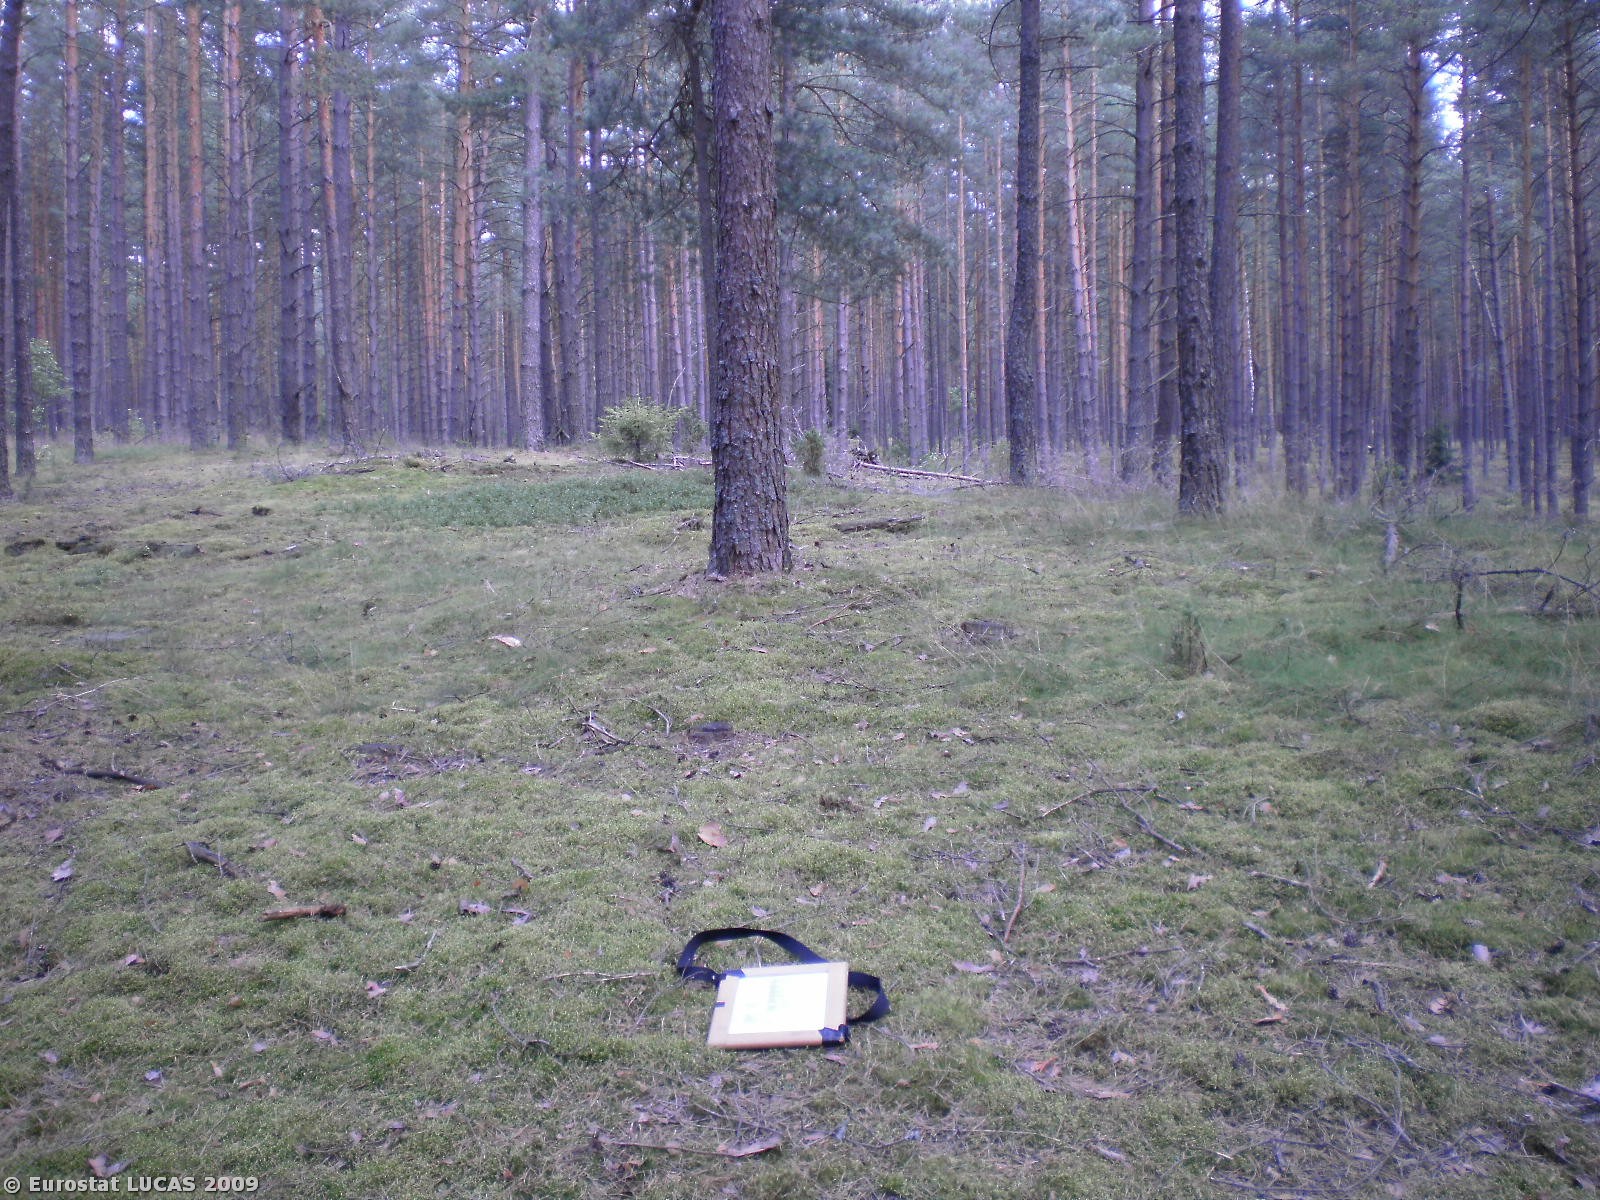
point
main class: Woodland
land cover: Coniferous woodland
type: hemiboreal forest and nemoral coniferous forest and mixed broadleaved-coniferous forest
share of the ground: 50 - 75 %
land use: Forestry
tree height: > 5 m
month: July
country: PL
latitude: 53.5483
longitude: 20.4352
